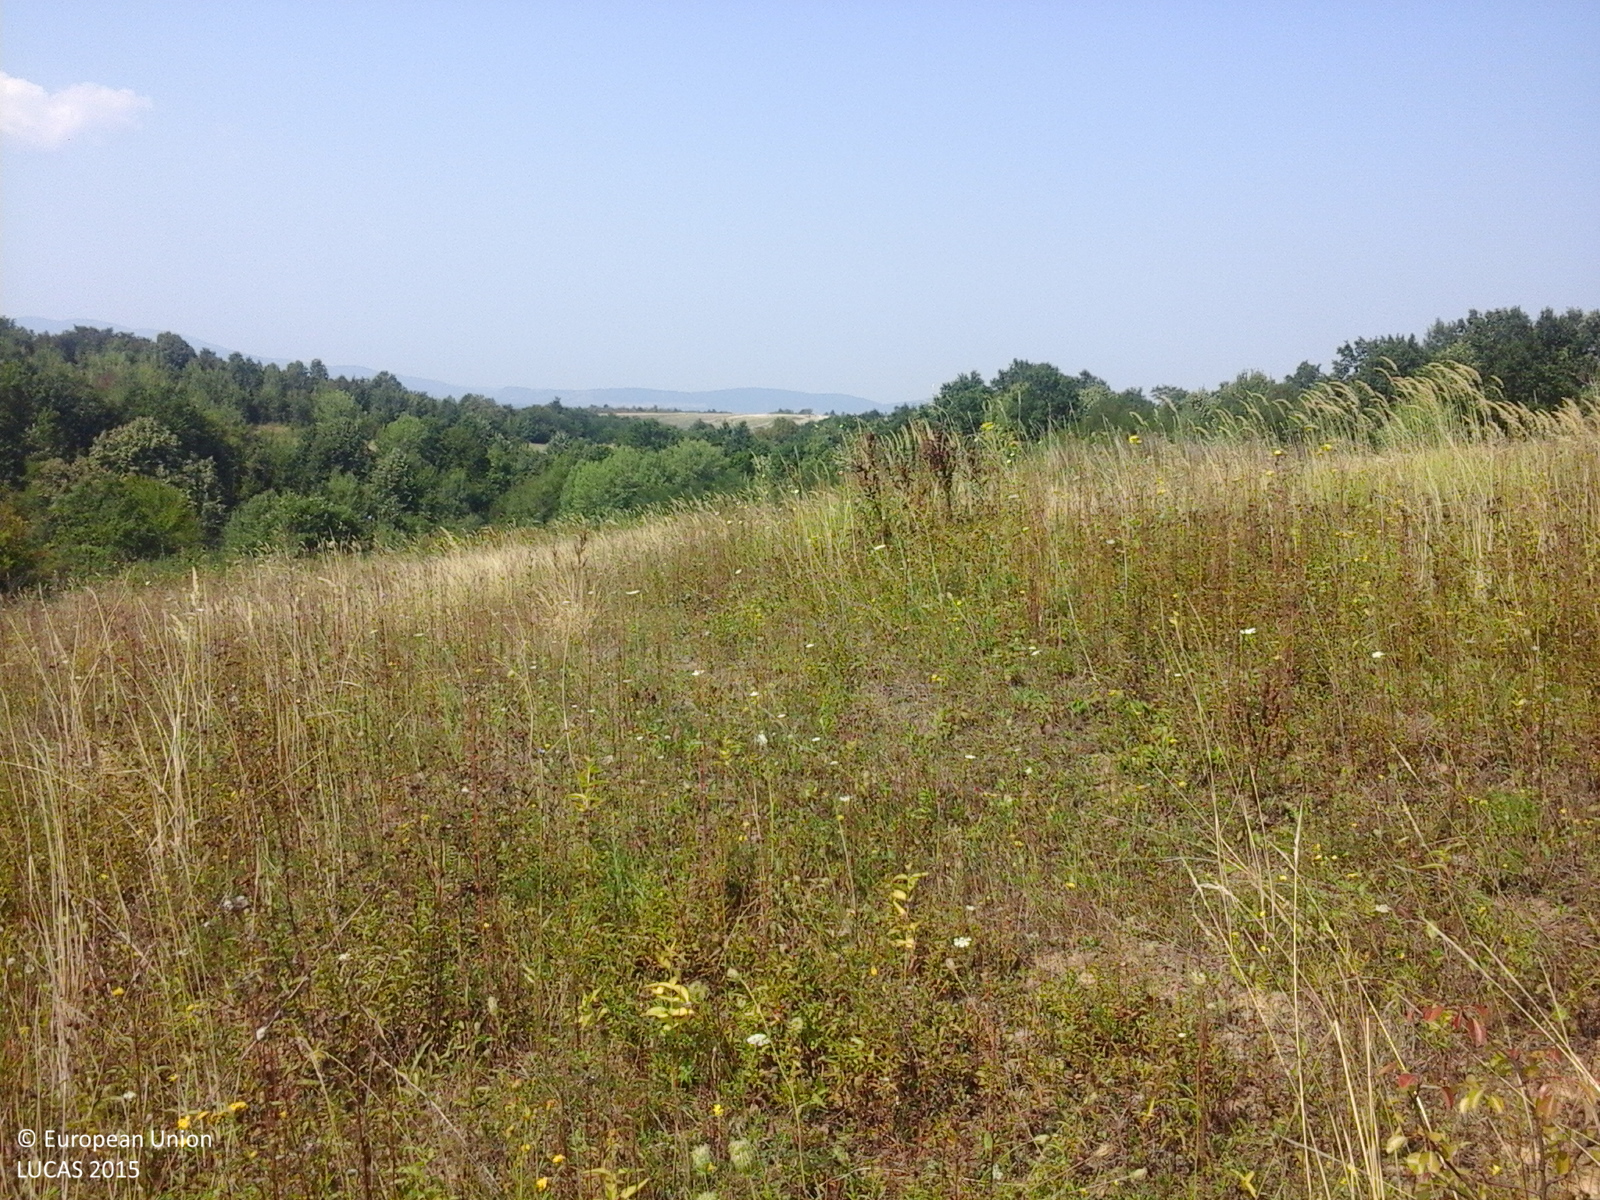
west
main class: Grassland
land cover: Grassland without tree/shrub cover
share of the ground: > 75 %
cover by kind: herbaceous plants 100 %
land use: Agriculture (excluding fallow land and kitchen gardens)
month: August
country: RO
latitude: 46.3069
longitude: 22.3443
